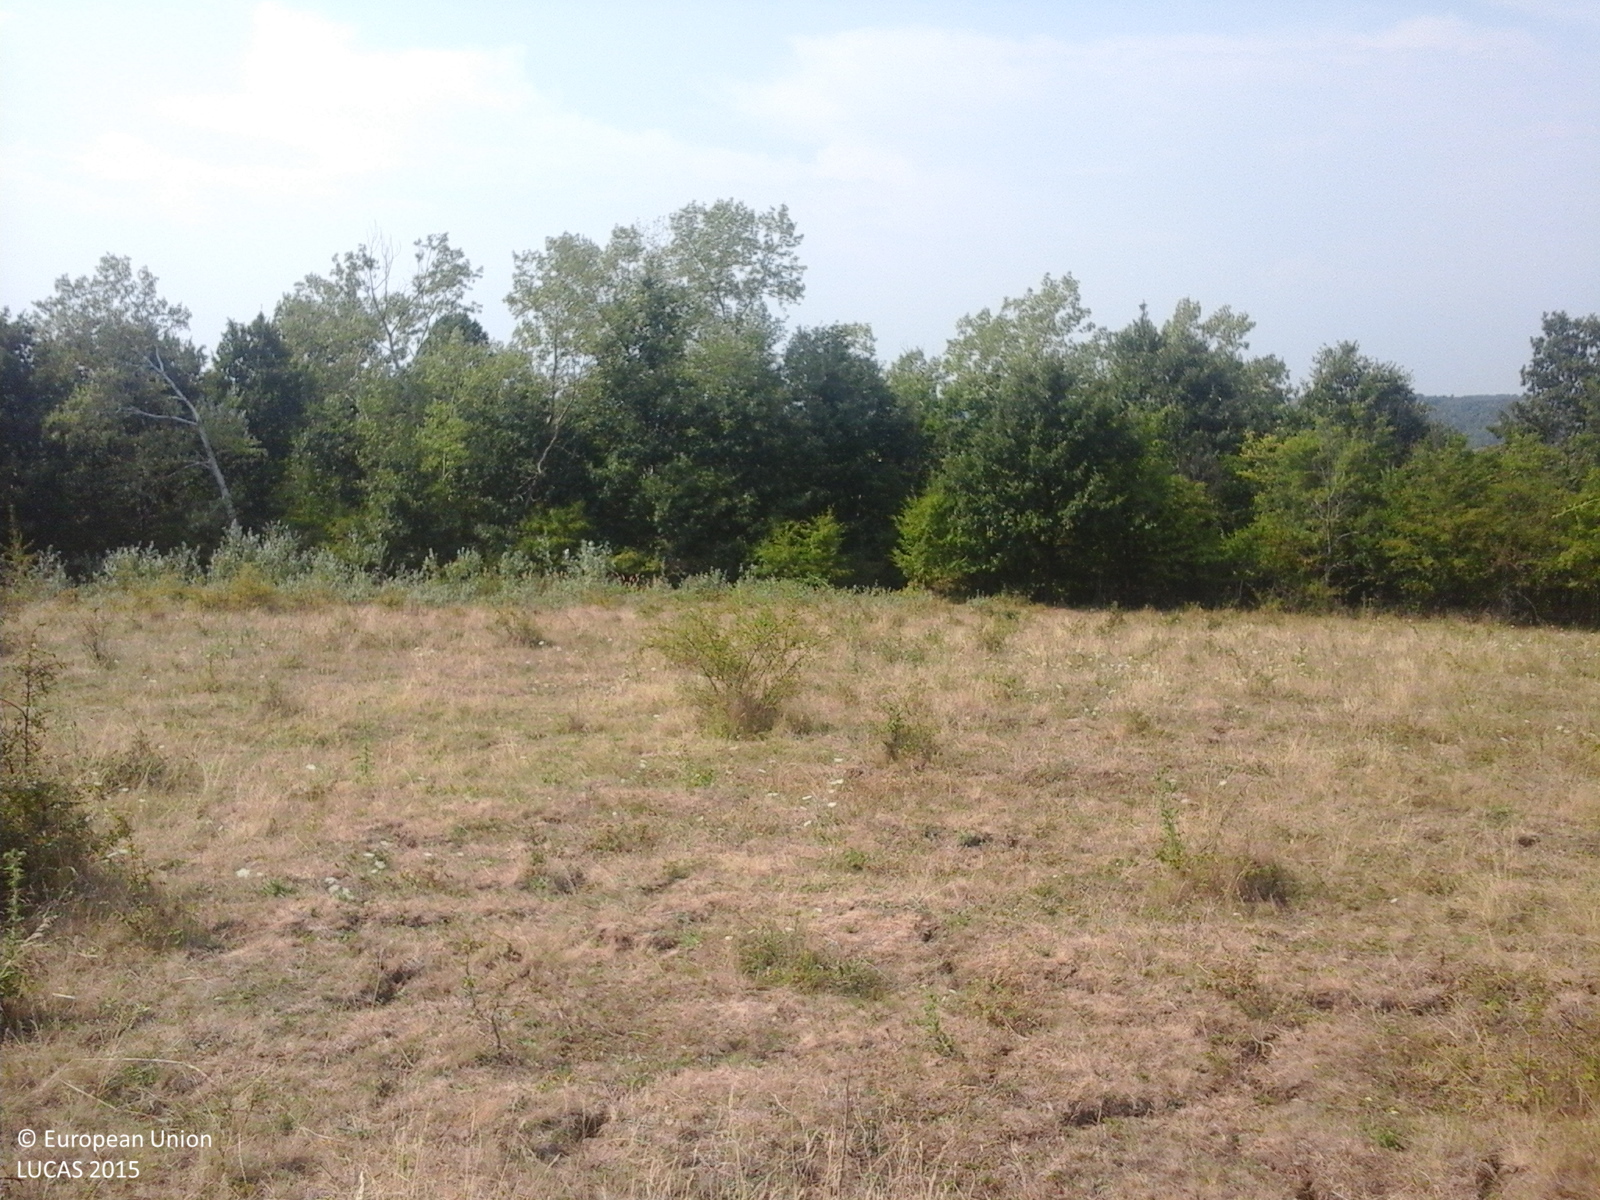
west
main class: Grassland
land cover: Grassland with sparse tree/shrub cover
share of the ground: > 75 %
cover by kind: herbaceous plants 85 %, shrubs 10 %, broadleaved forest trees 5 %
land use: Fallow land
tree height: < 5 m
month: August
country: RO
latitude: 44.6364
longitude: 23.0444
